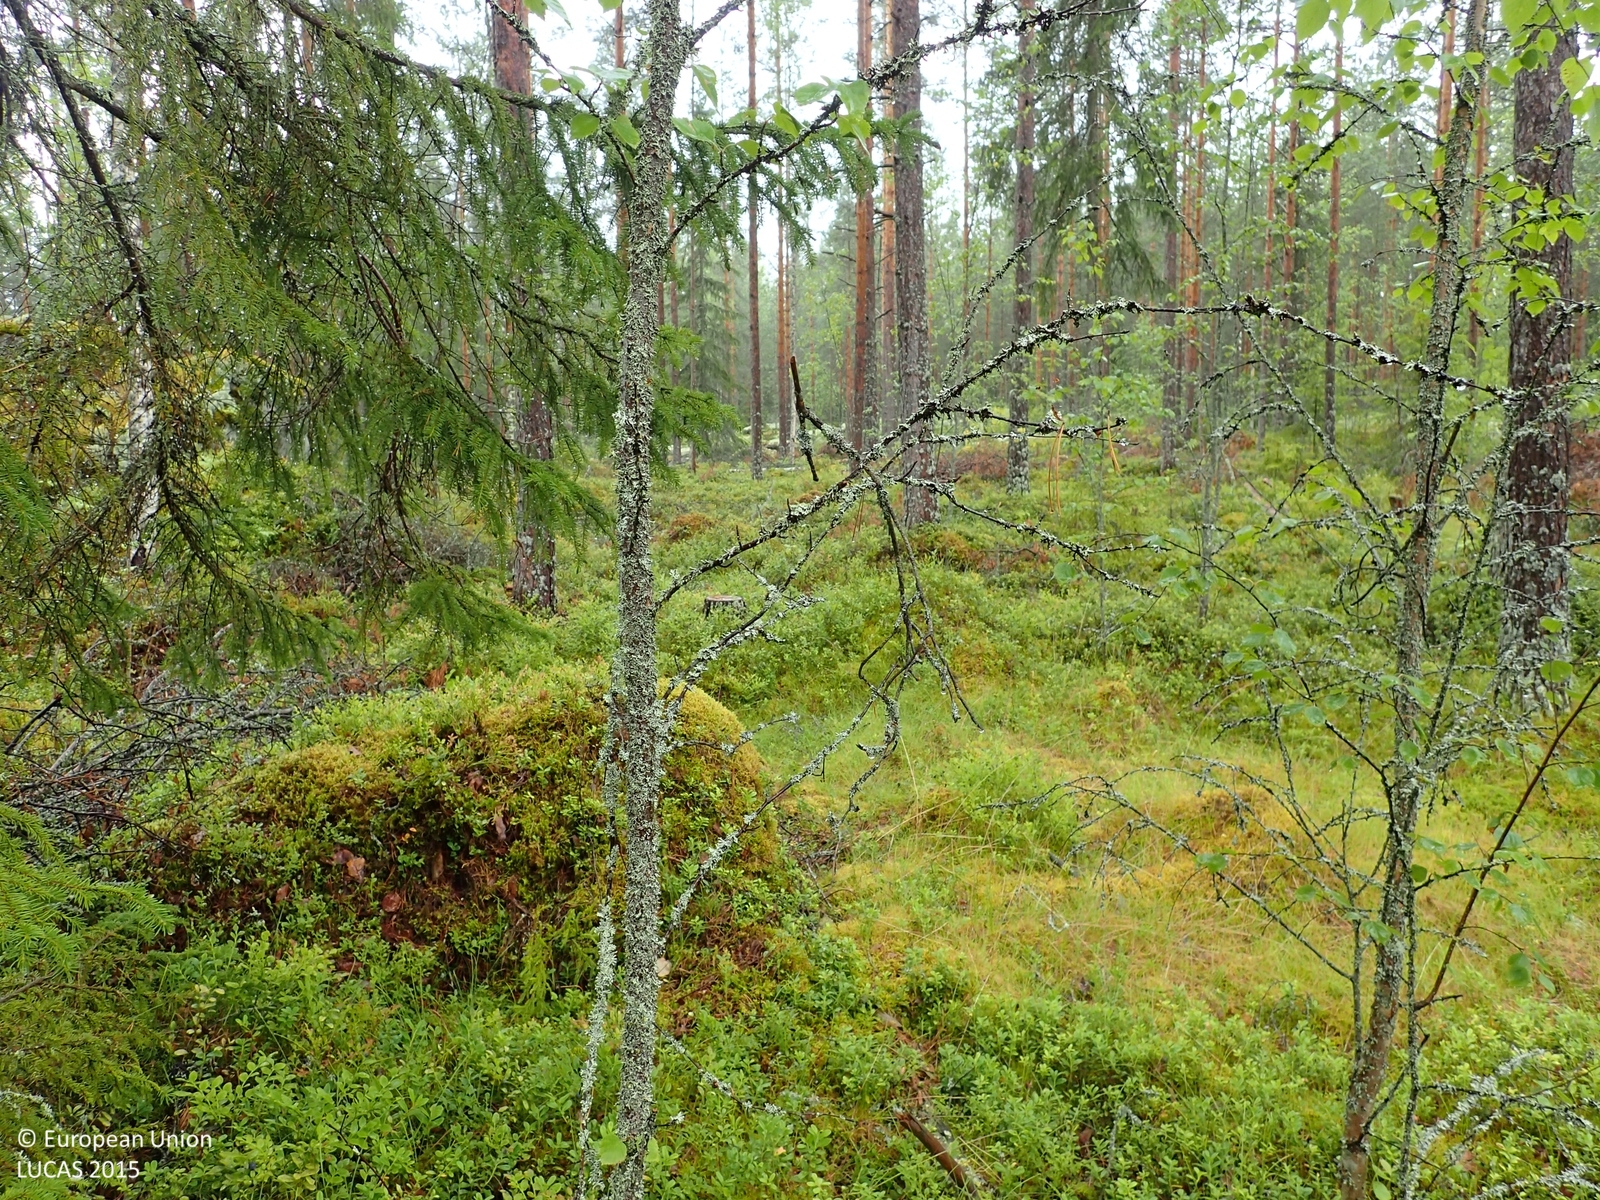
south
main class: Woodland
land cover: Pine dominated coniferous woodland
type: boreal forest
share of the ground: 50 - 75 %
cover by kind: coniferous forest trees 45 %, shrubs 40 %, broadleaved forest trees 10 %, lichens and mosses 5 %
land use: Forestry
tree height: > 5 m
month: July
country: FI
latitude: 63.0193
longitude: 22.7585
